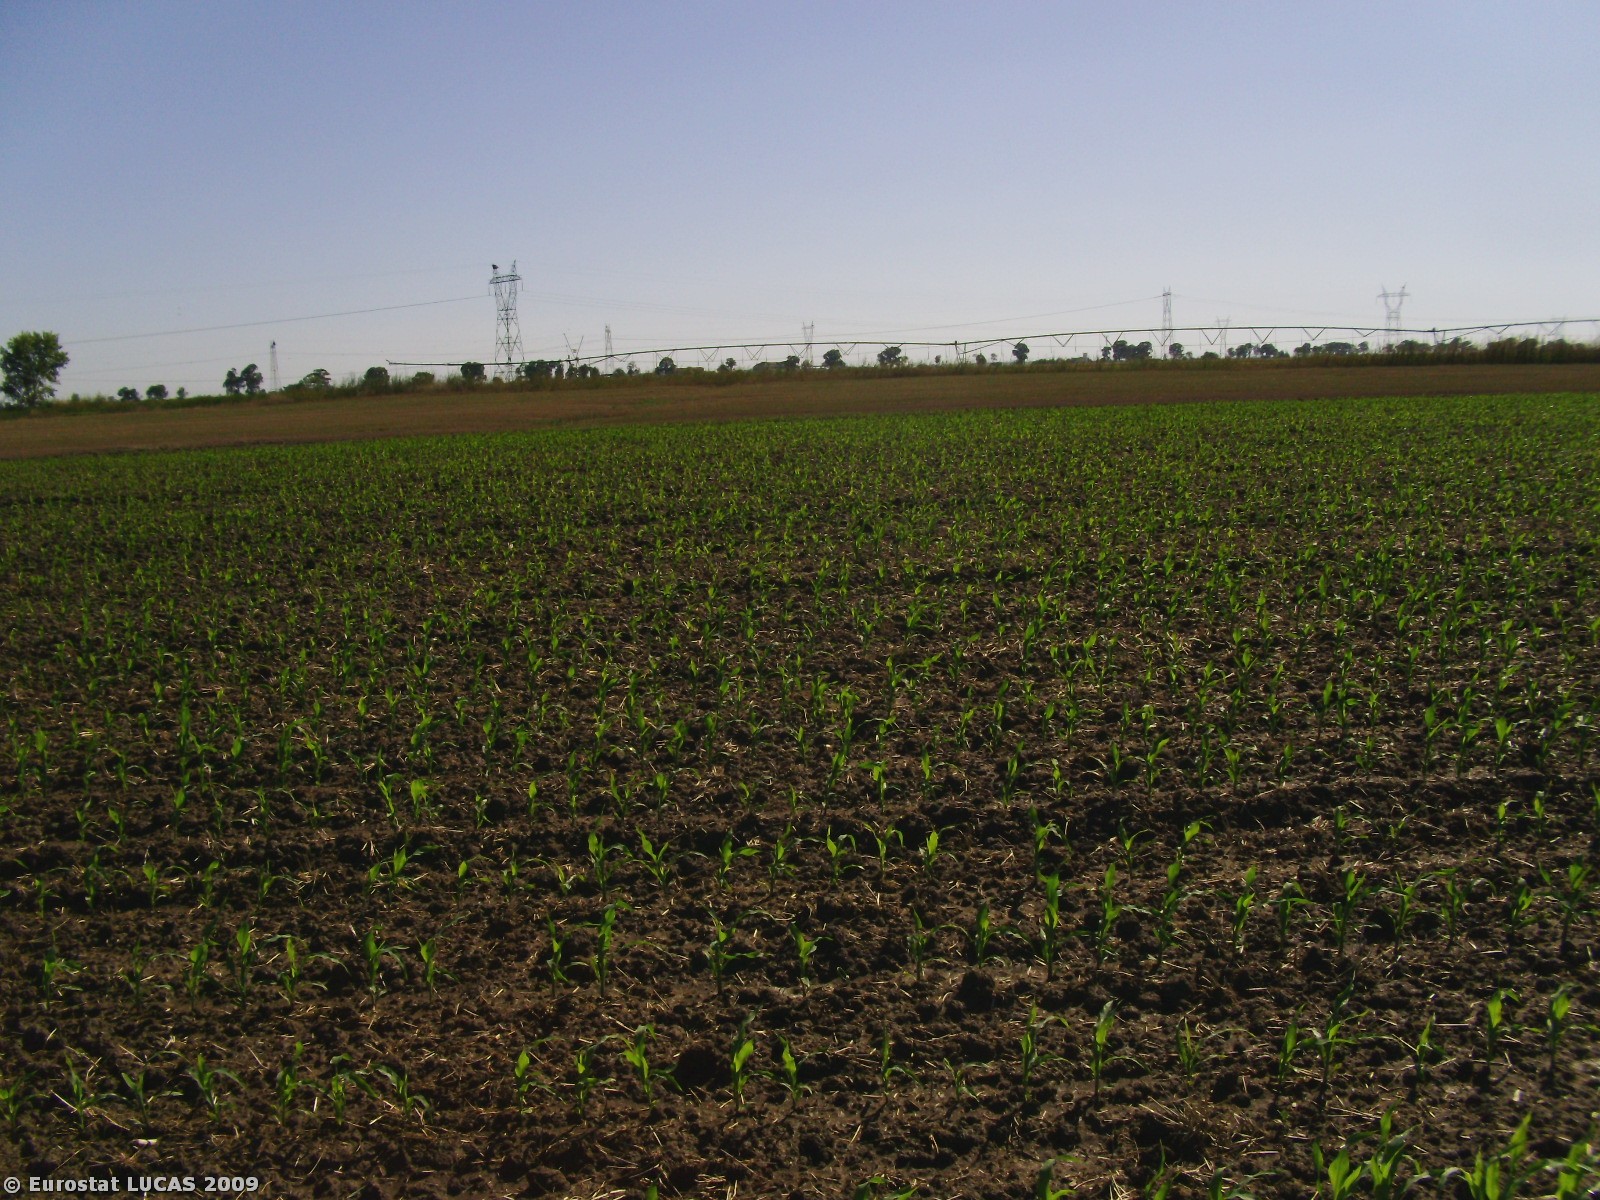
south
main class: Cropland
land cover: Maize
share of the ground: 50 - 75 %
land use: Agriculture (excluding fallow land and kitchen gardens)
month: July
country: PT
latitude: 38.9366
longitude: -8.9595
